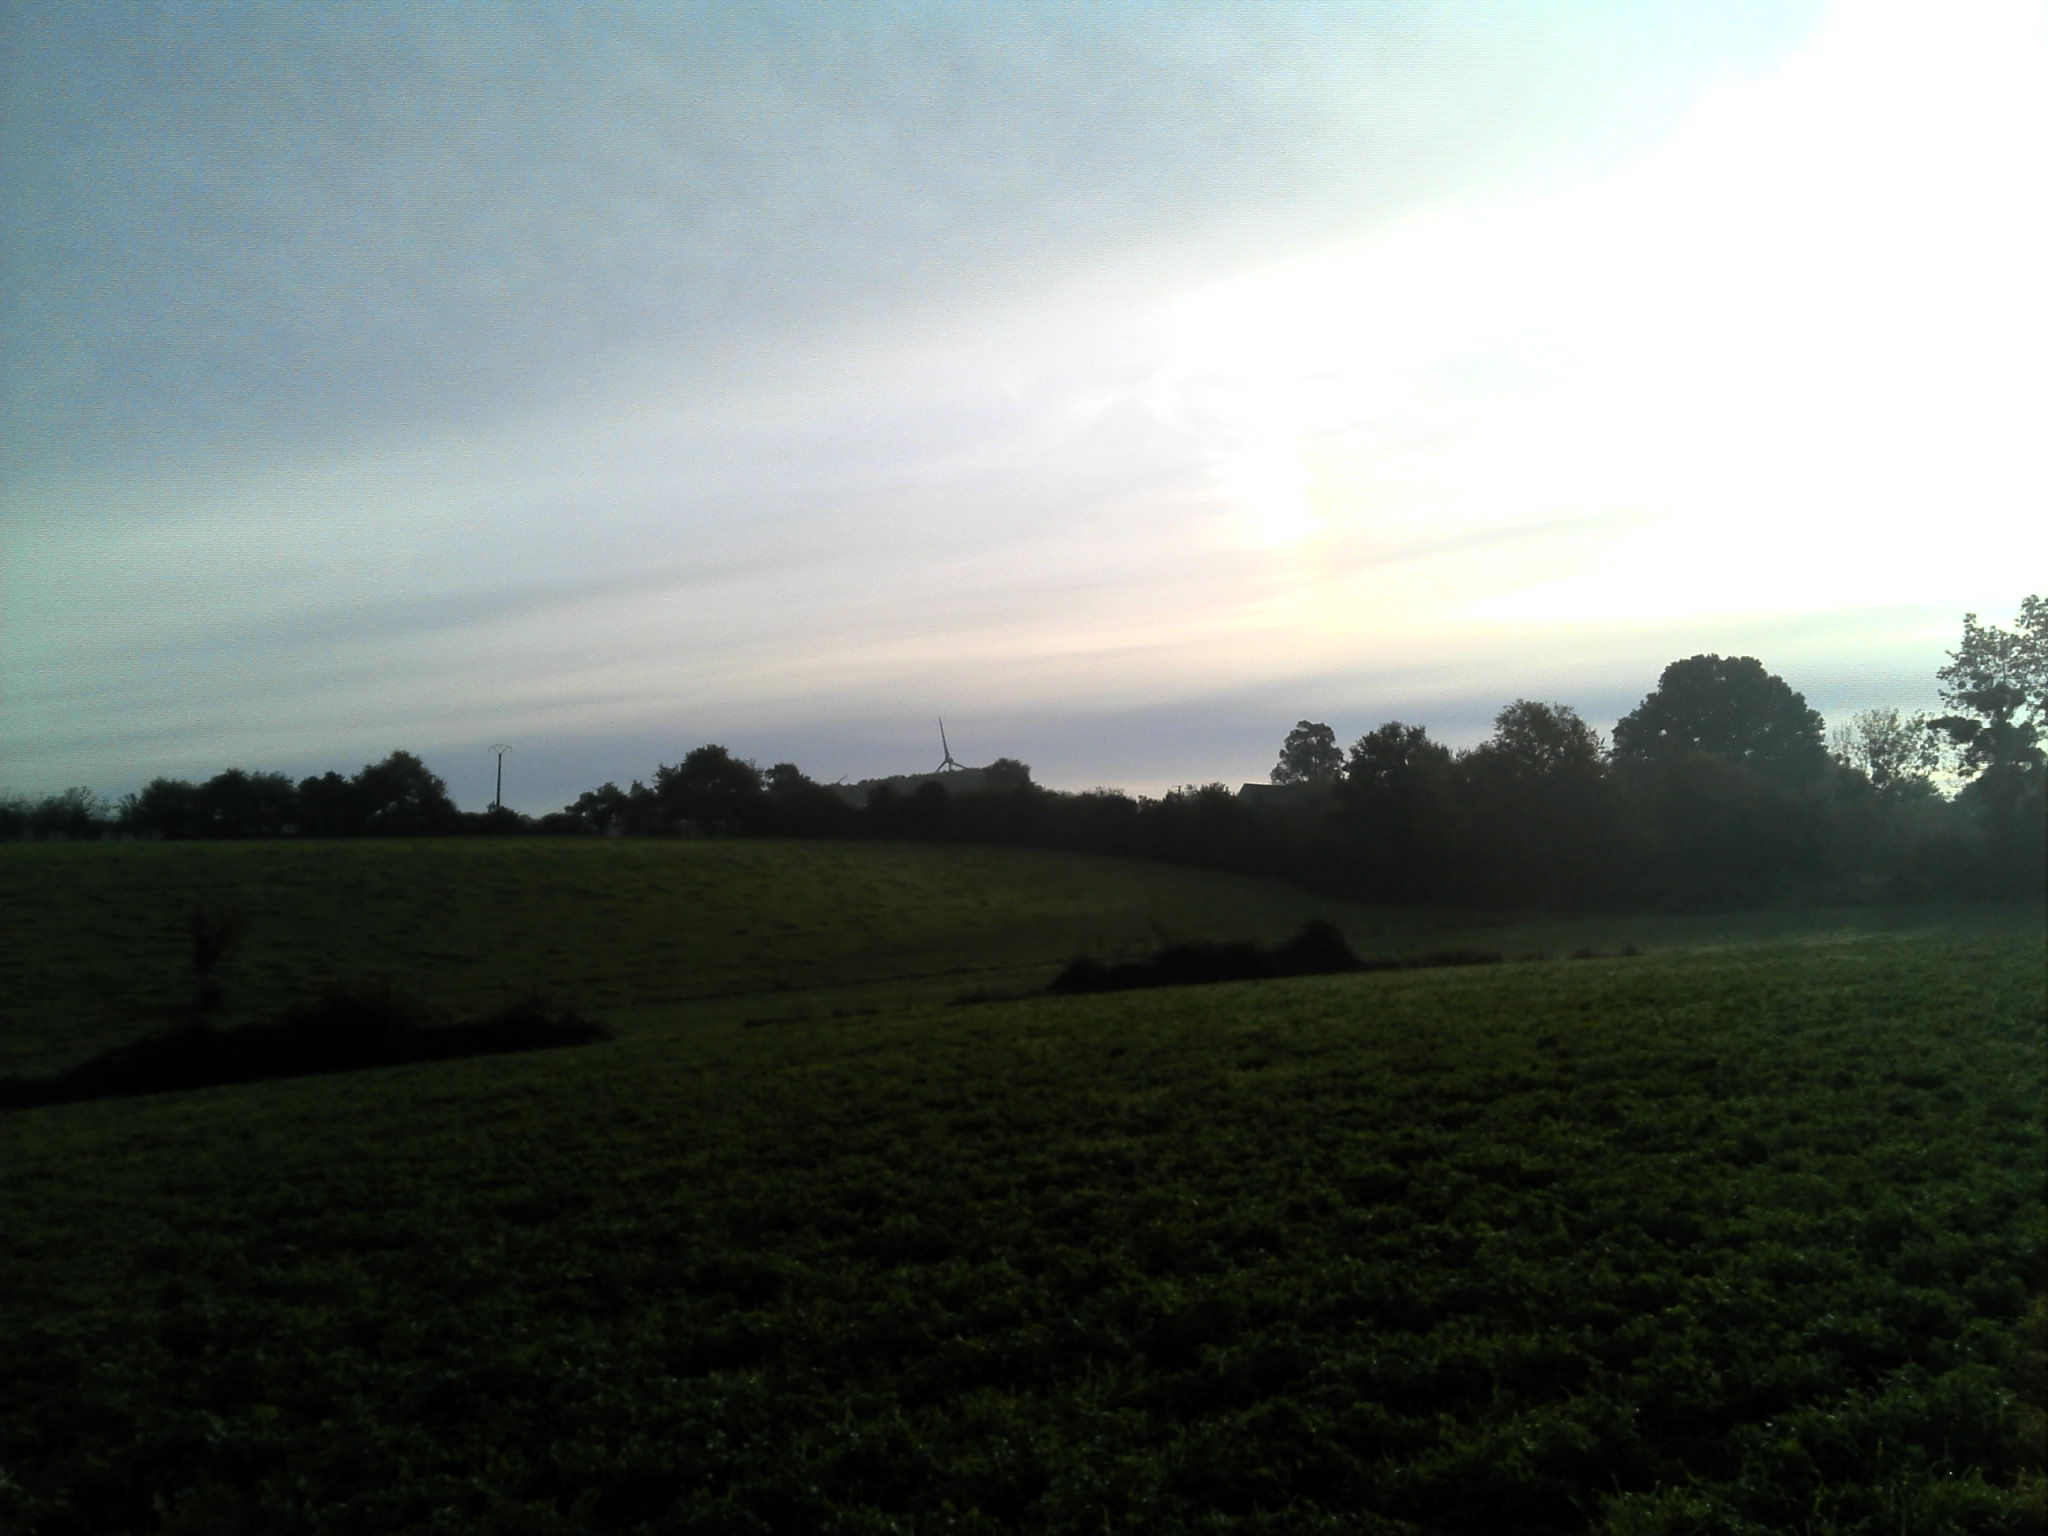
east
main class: Cropland
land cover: Lucerne
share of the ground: > 75 %
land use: Agriculture (excluding fallow land and kitchen gardens)
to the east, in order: Lucerne; Managed hedges; Lucerne; Ditches and canals; Fences; Grassland without tree/shrub cover; Fences; Managed hedges; Fences; Grassland without tree/shrub cover
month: October
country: FR
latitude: 47.2777
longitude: -0.9412
